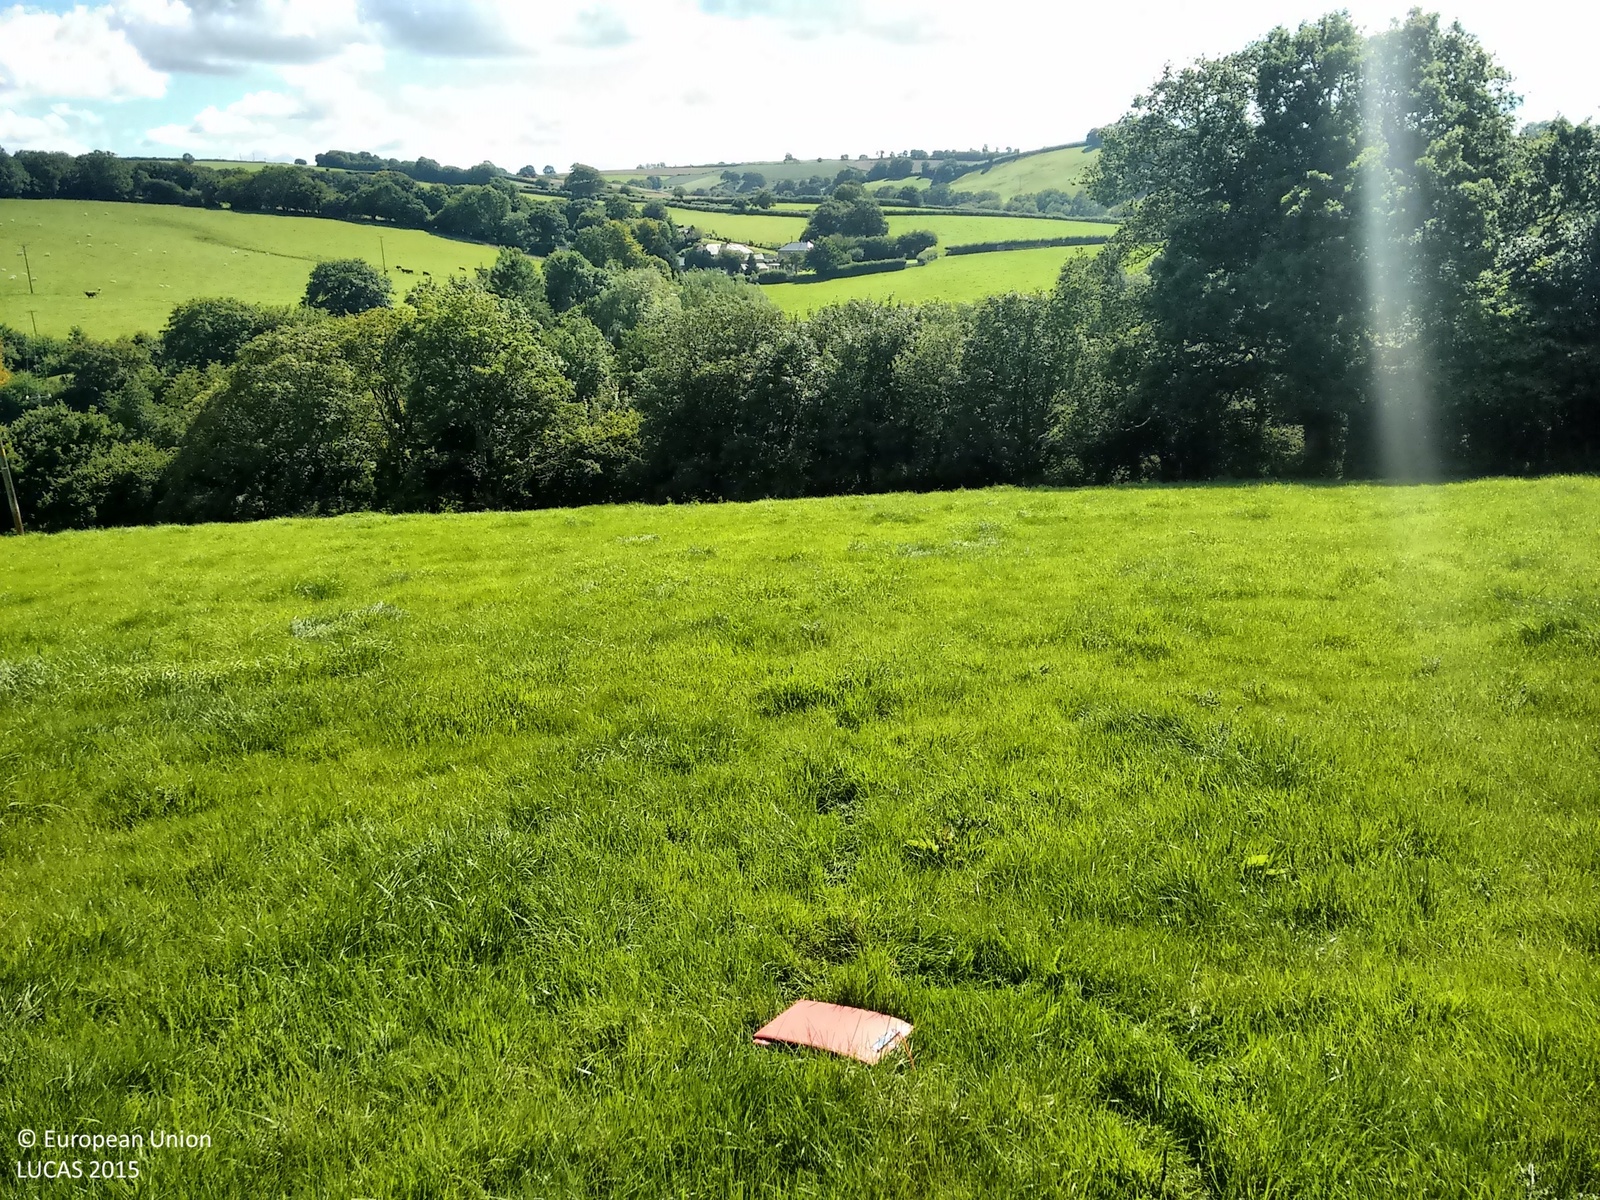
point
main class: Grassland
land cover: Grassland without tree/shrub cover
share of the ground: > 75 %
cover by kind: herbaceous plants 100 %
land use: Agriculture (excluding fallow land and kitchen gardens)
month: September
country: GB
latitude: 50.5714
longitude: -4.3190
